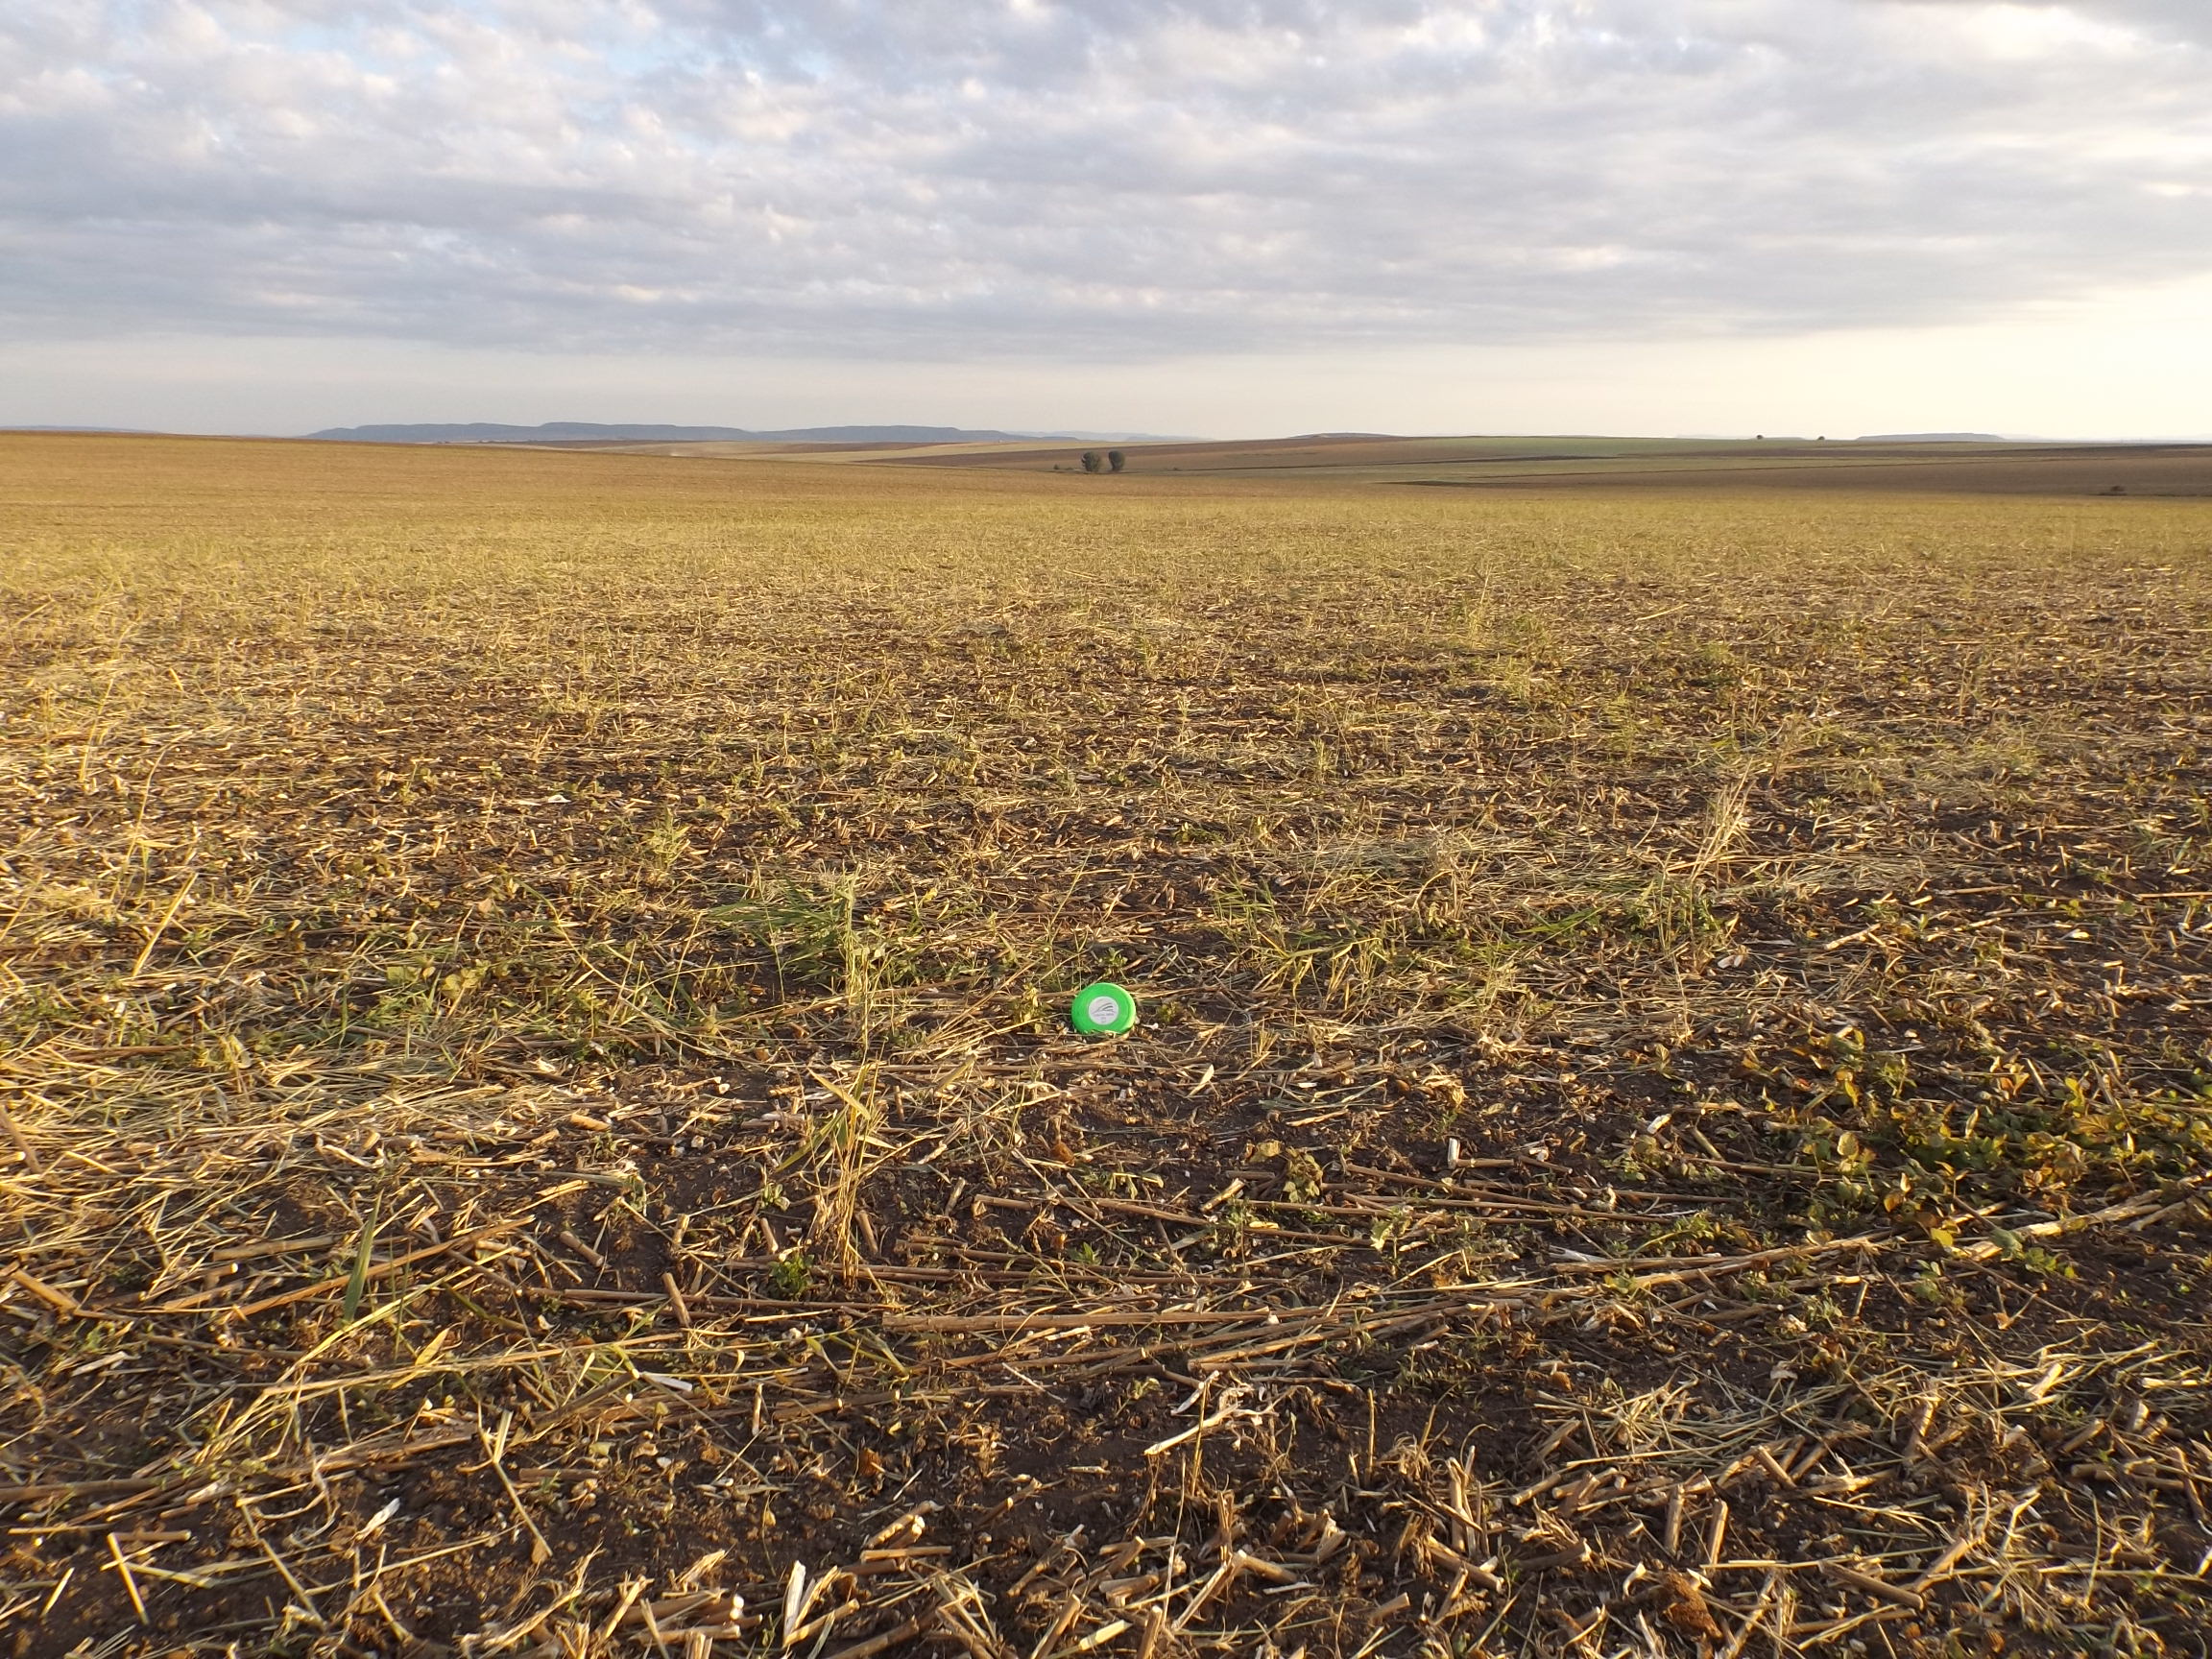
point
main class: Cropland
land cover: Sunflower
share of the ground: < 10 %
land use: Agriculture (excluding fallow land and kitchen gardens)
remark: Harvested field
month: September
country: BG
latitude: 43.3748
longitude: 27.4437
